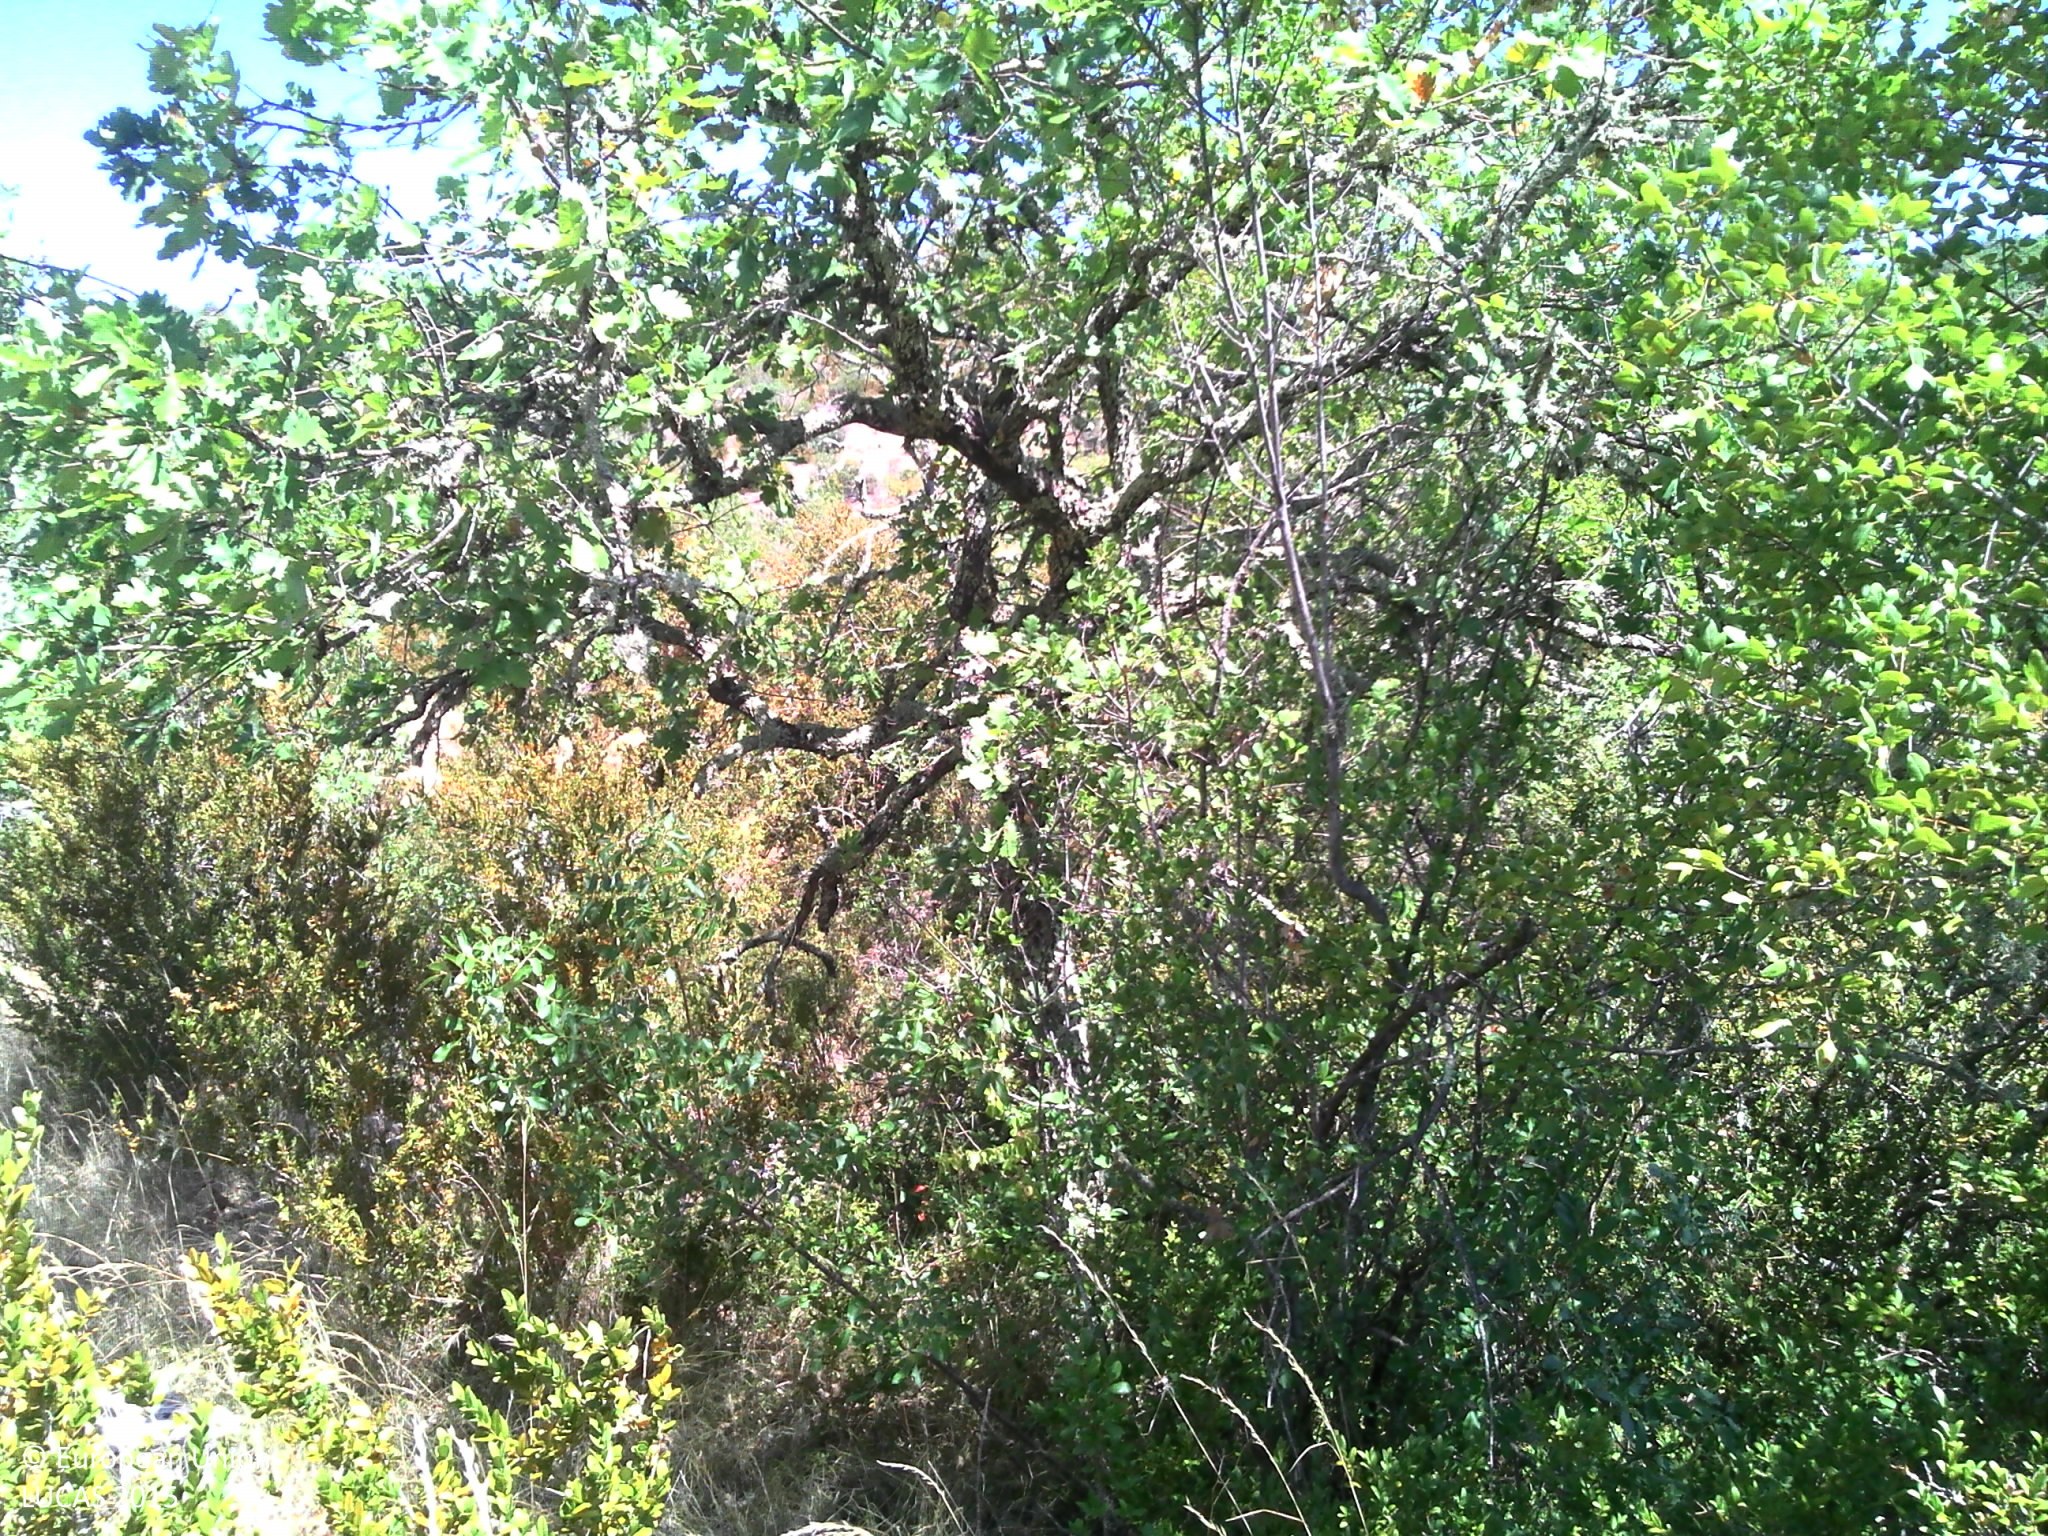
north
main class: Shrubland
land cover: Shrubland with sparse tree cover
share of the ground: > 75 %
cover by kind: shrubs 95 %, broadleaved forest trees 5 %
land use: Semi-natural and natural areas not in use
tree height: > 5 m
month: July
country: FR
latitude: 44.4270
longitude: 4.2662
